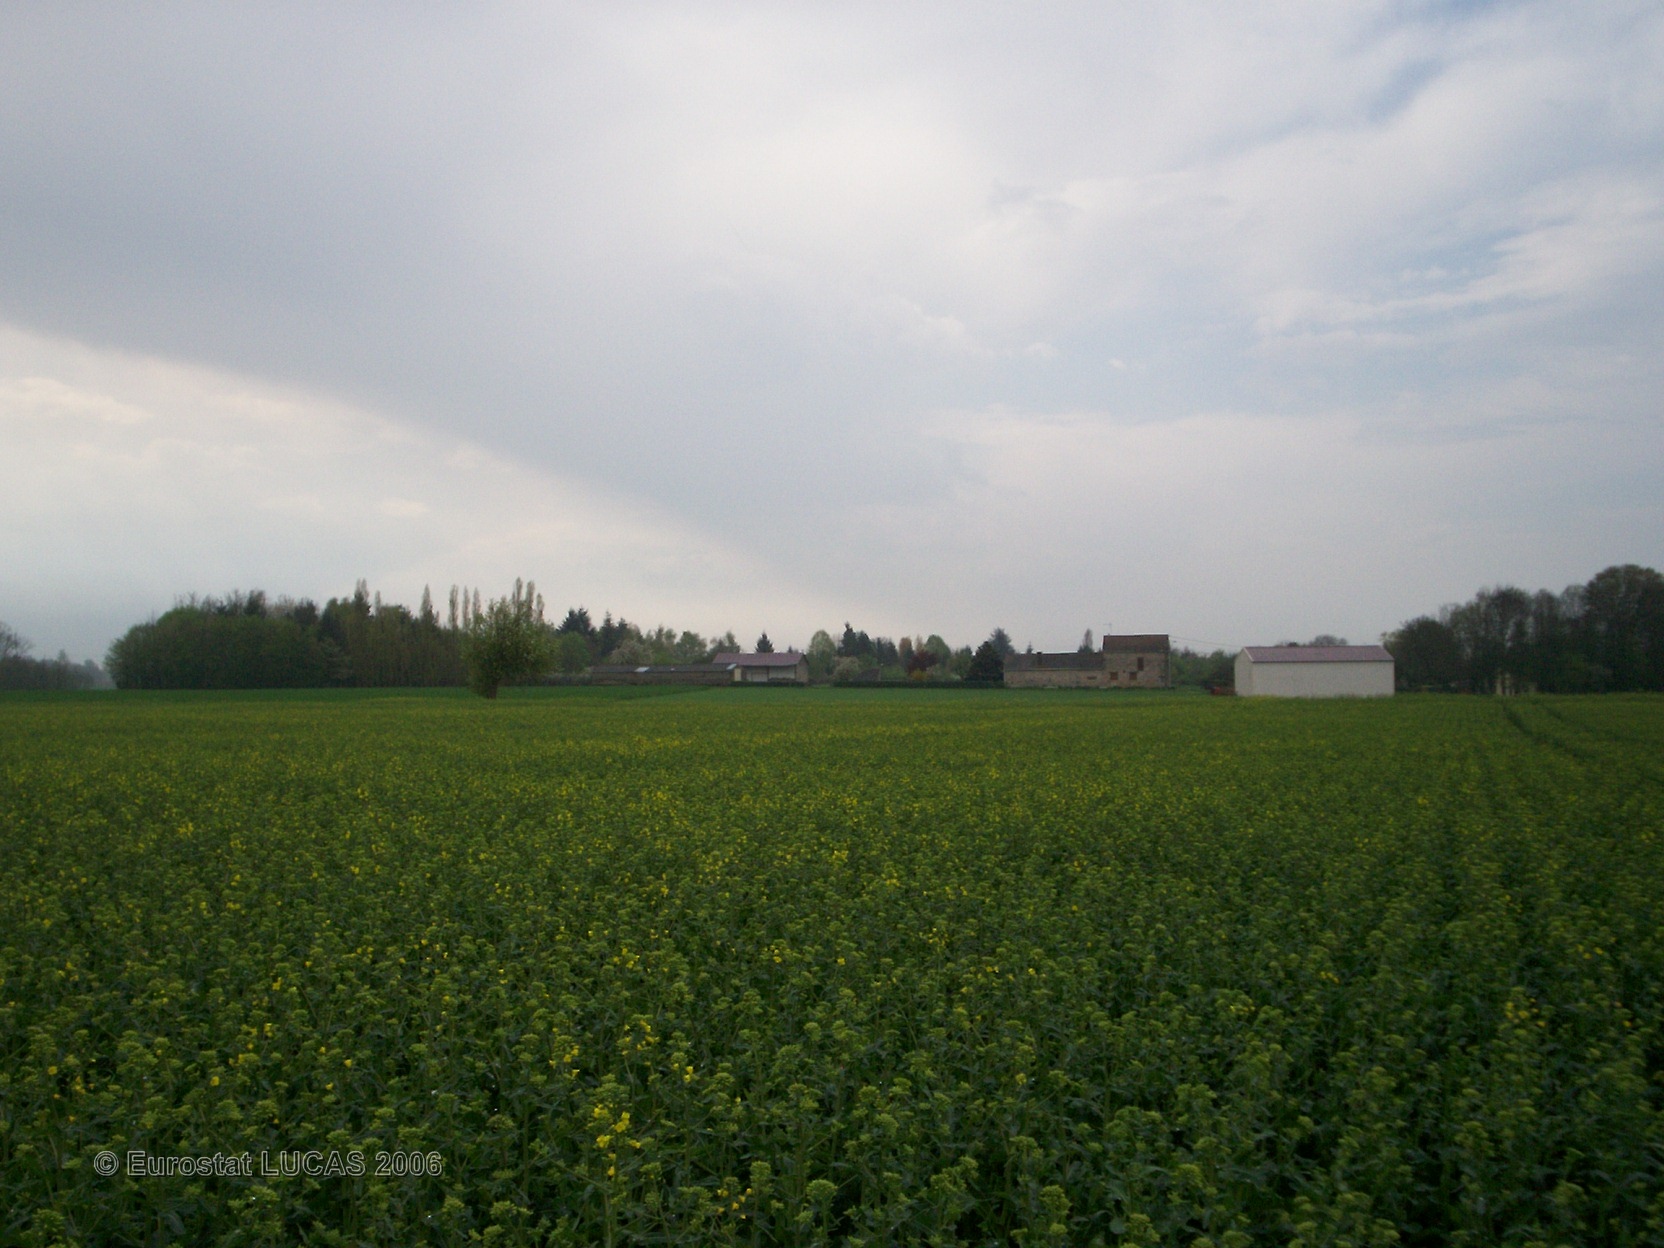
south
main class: Cropland
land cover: Rape and turnip rape
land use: Agriculture (excluding fallow land and kitchen gardens)
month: April
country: FR
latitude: 48.2505
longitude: 2.9485
